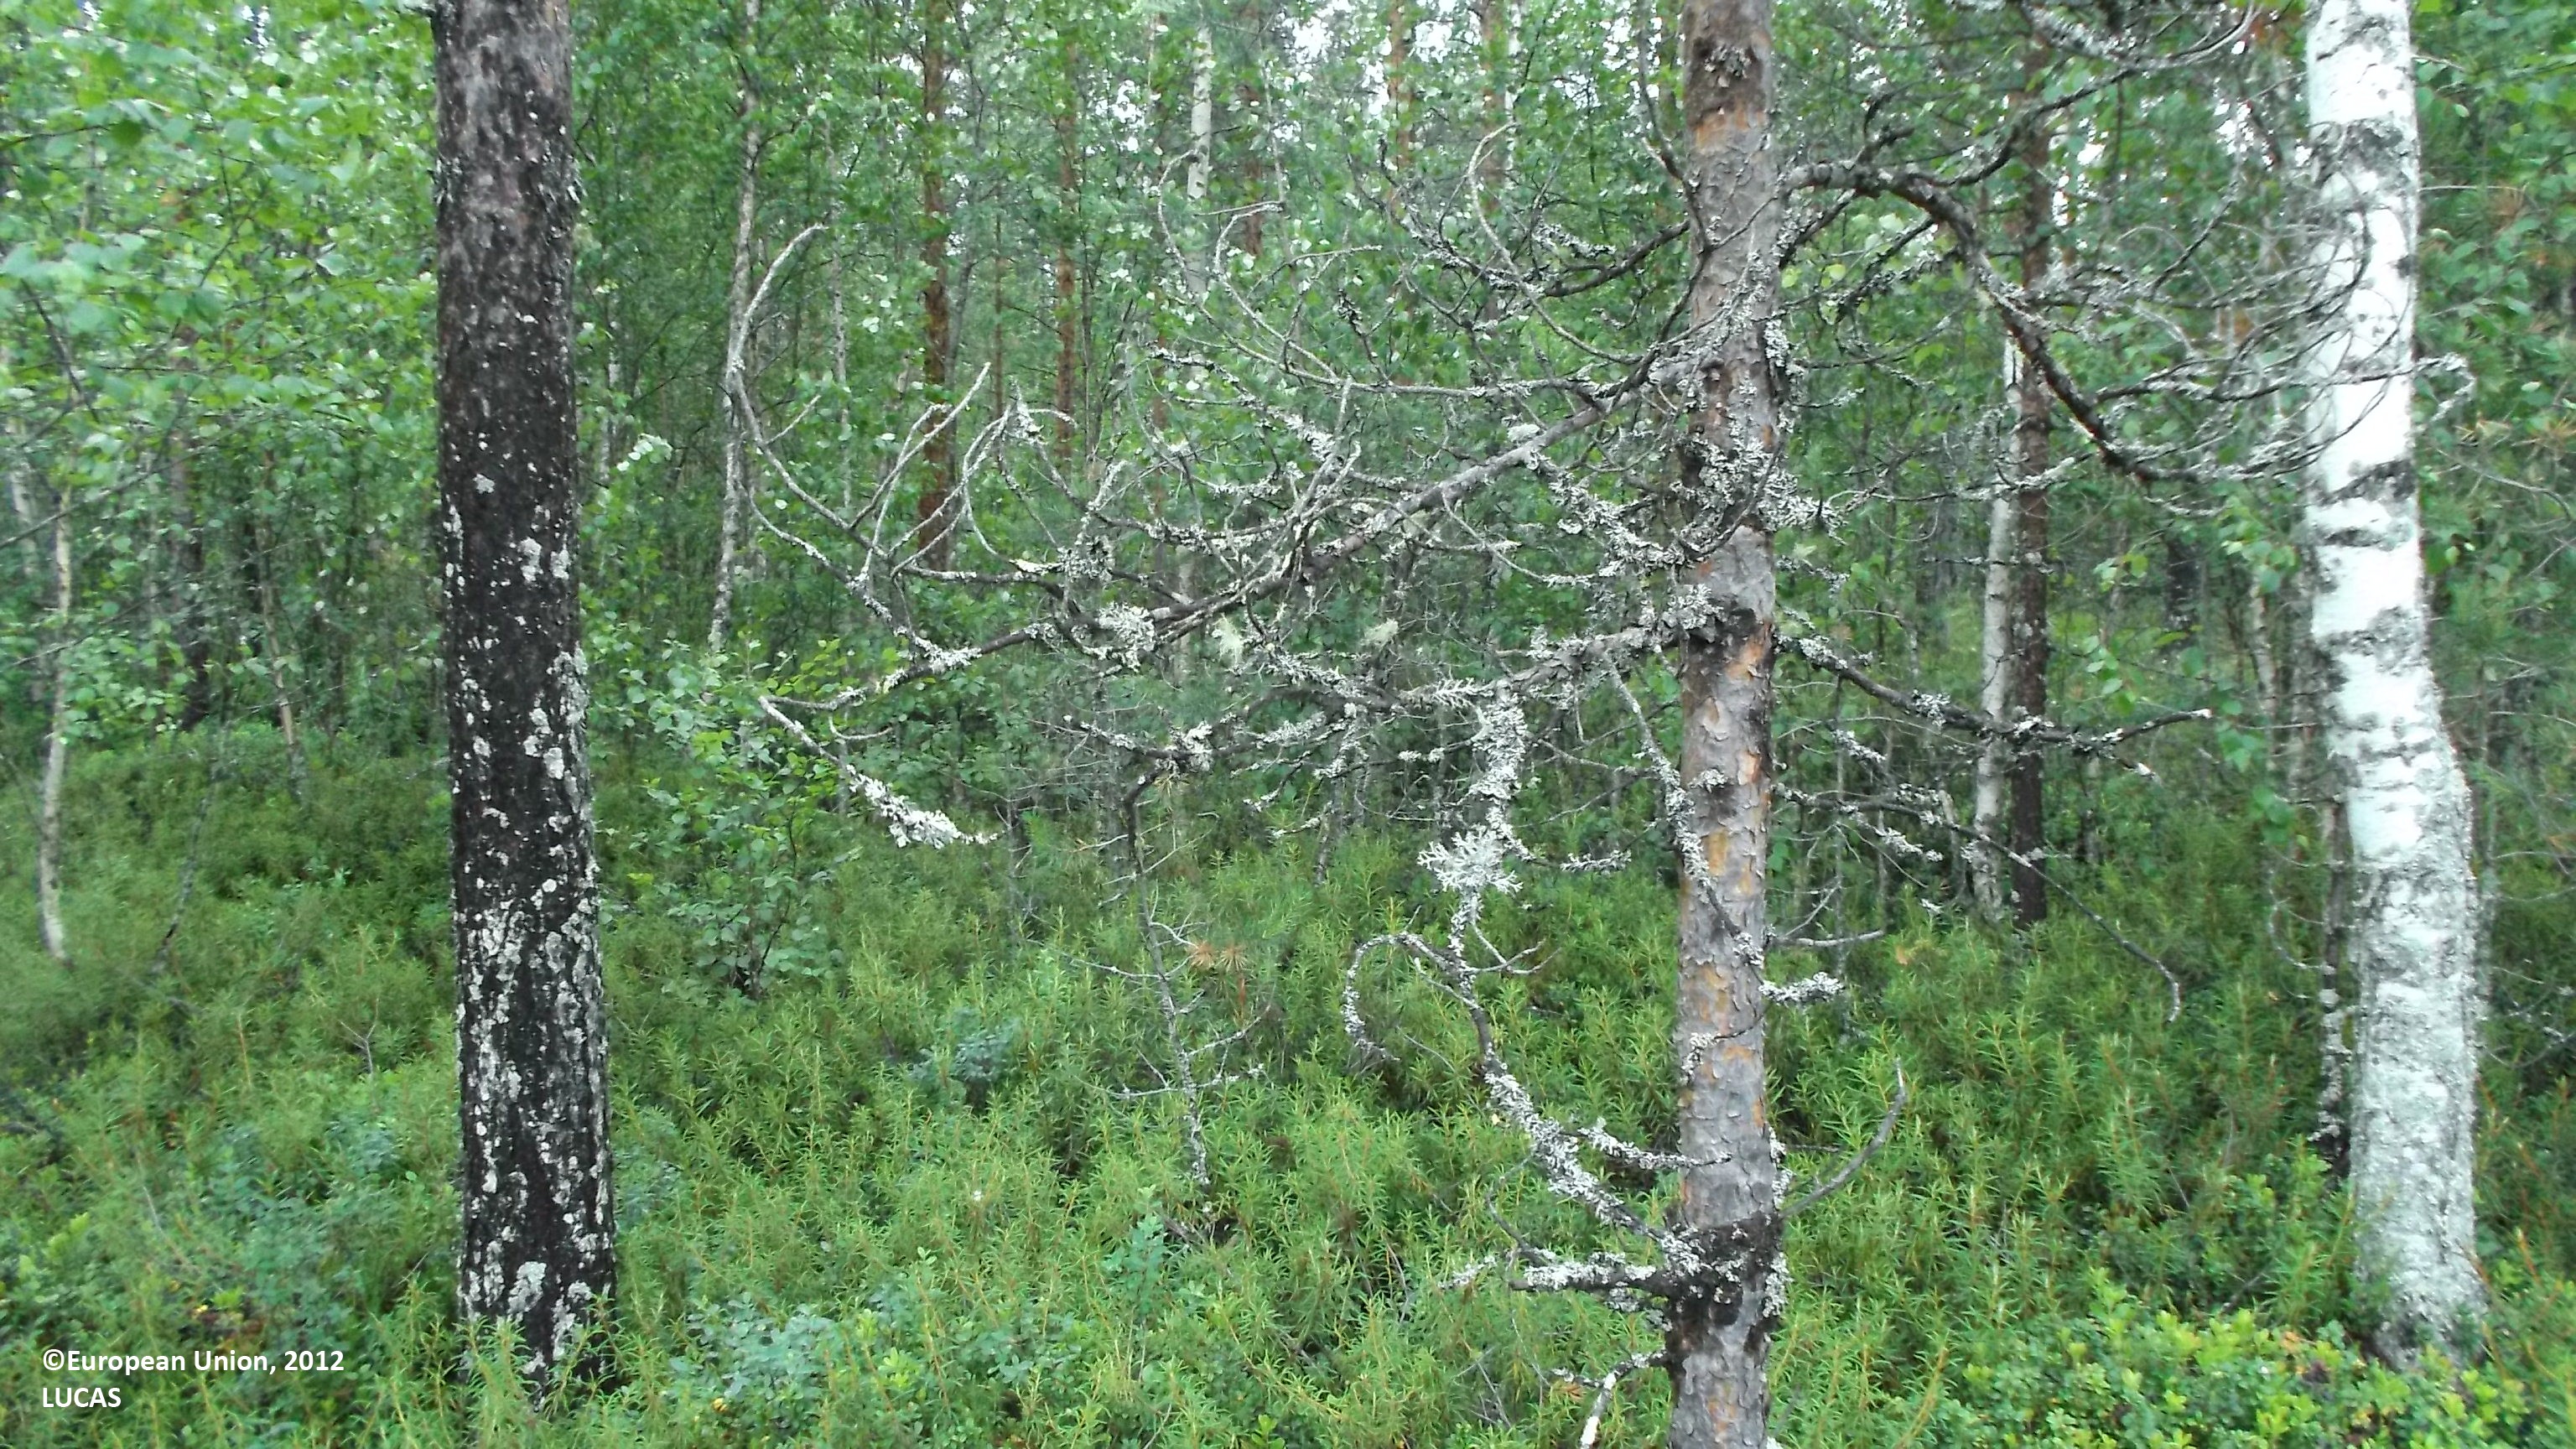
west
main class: Woodland
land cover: Other mixed woodland
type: boreal forest
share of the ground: 50 - 75 %
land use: Forestry
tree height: > 5 m
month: July
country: FI
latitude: 63.3928
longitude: 23.9394
